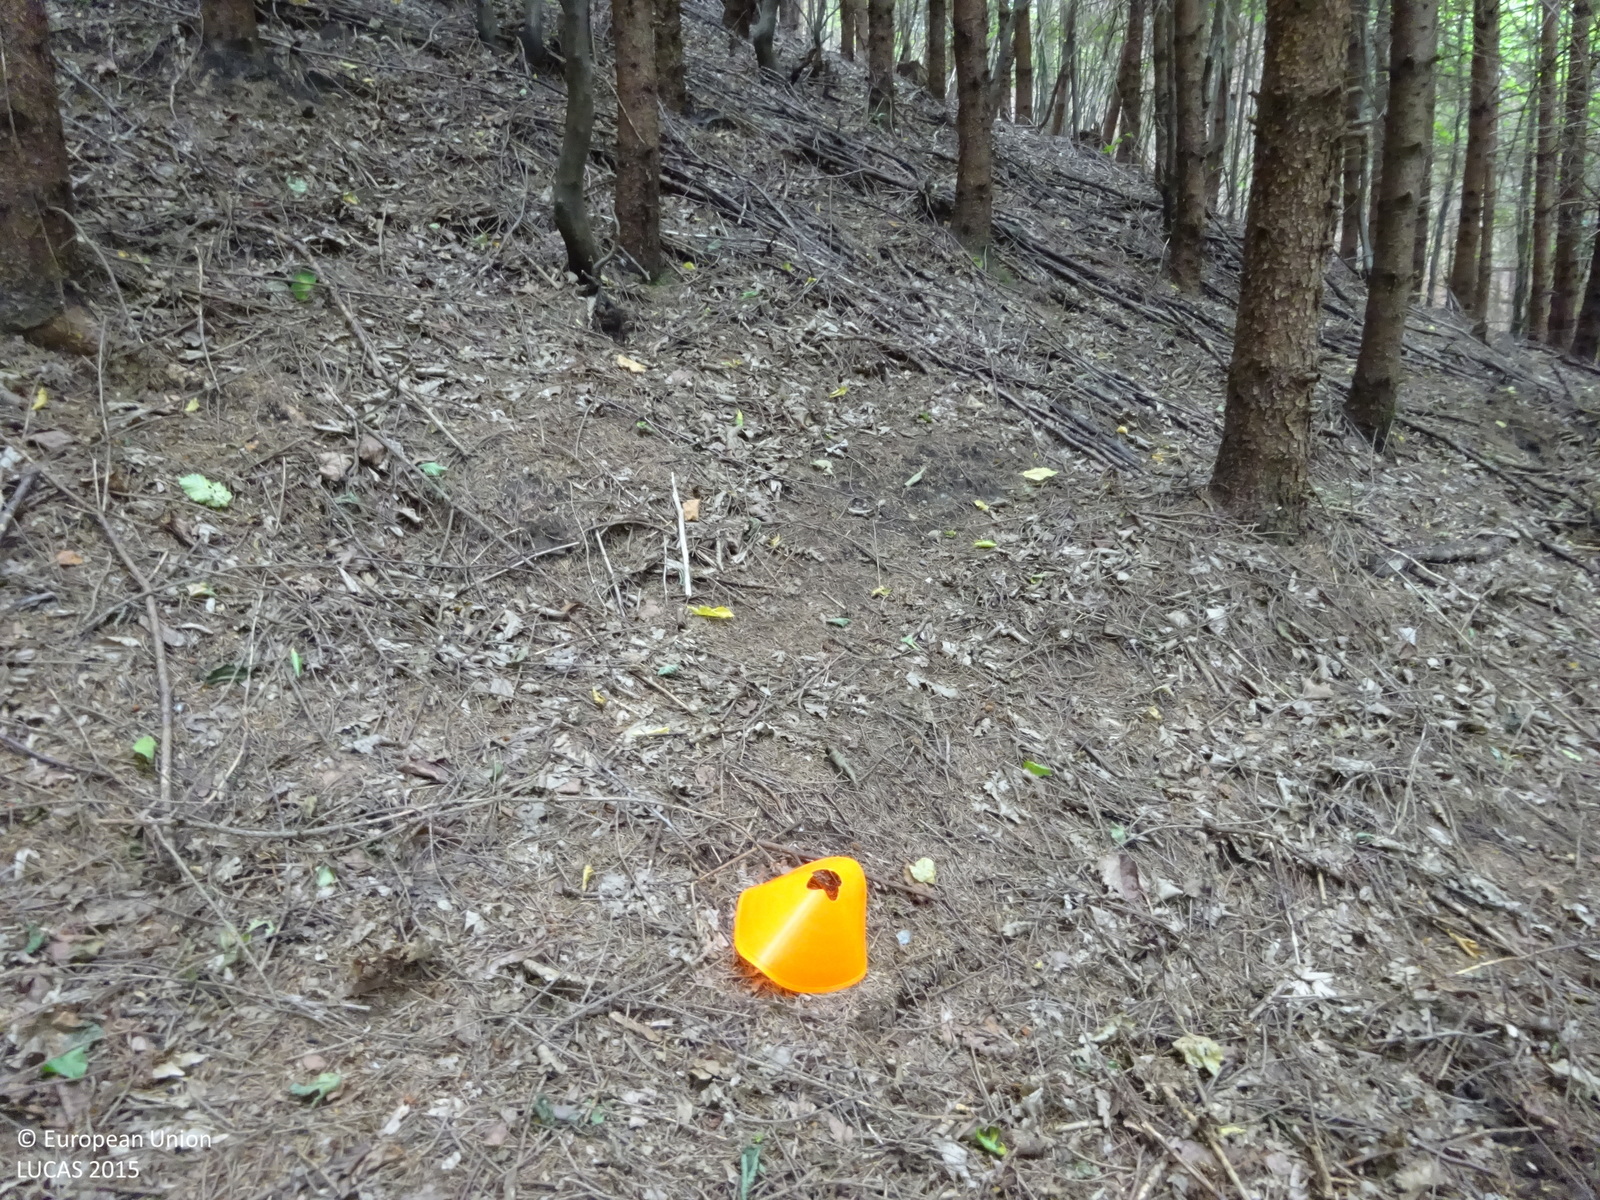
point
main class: Woodland
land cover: Spruce dominated coniferous woodland
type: alpine coniferous forest
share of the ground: > 75 %
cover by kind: coniferous forest trees 95 %, broadleaved forest trees 5 %
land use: Forestry
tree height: > 5 m
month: July
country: AT
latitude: 47.0381
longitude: 15.1714
